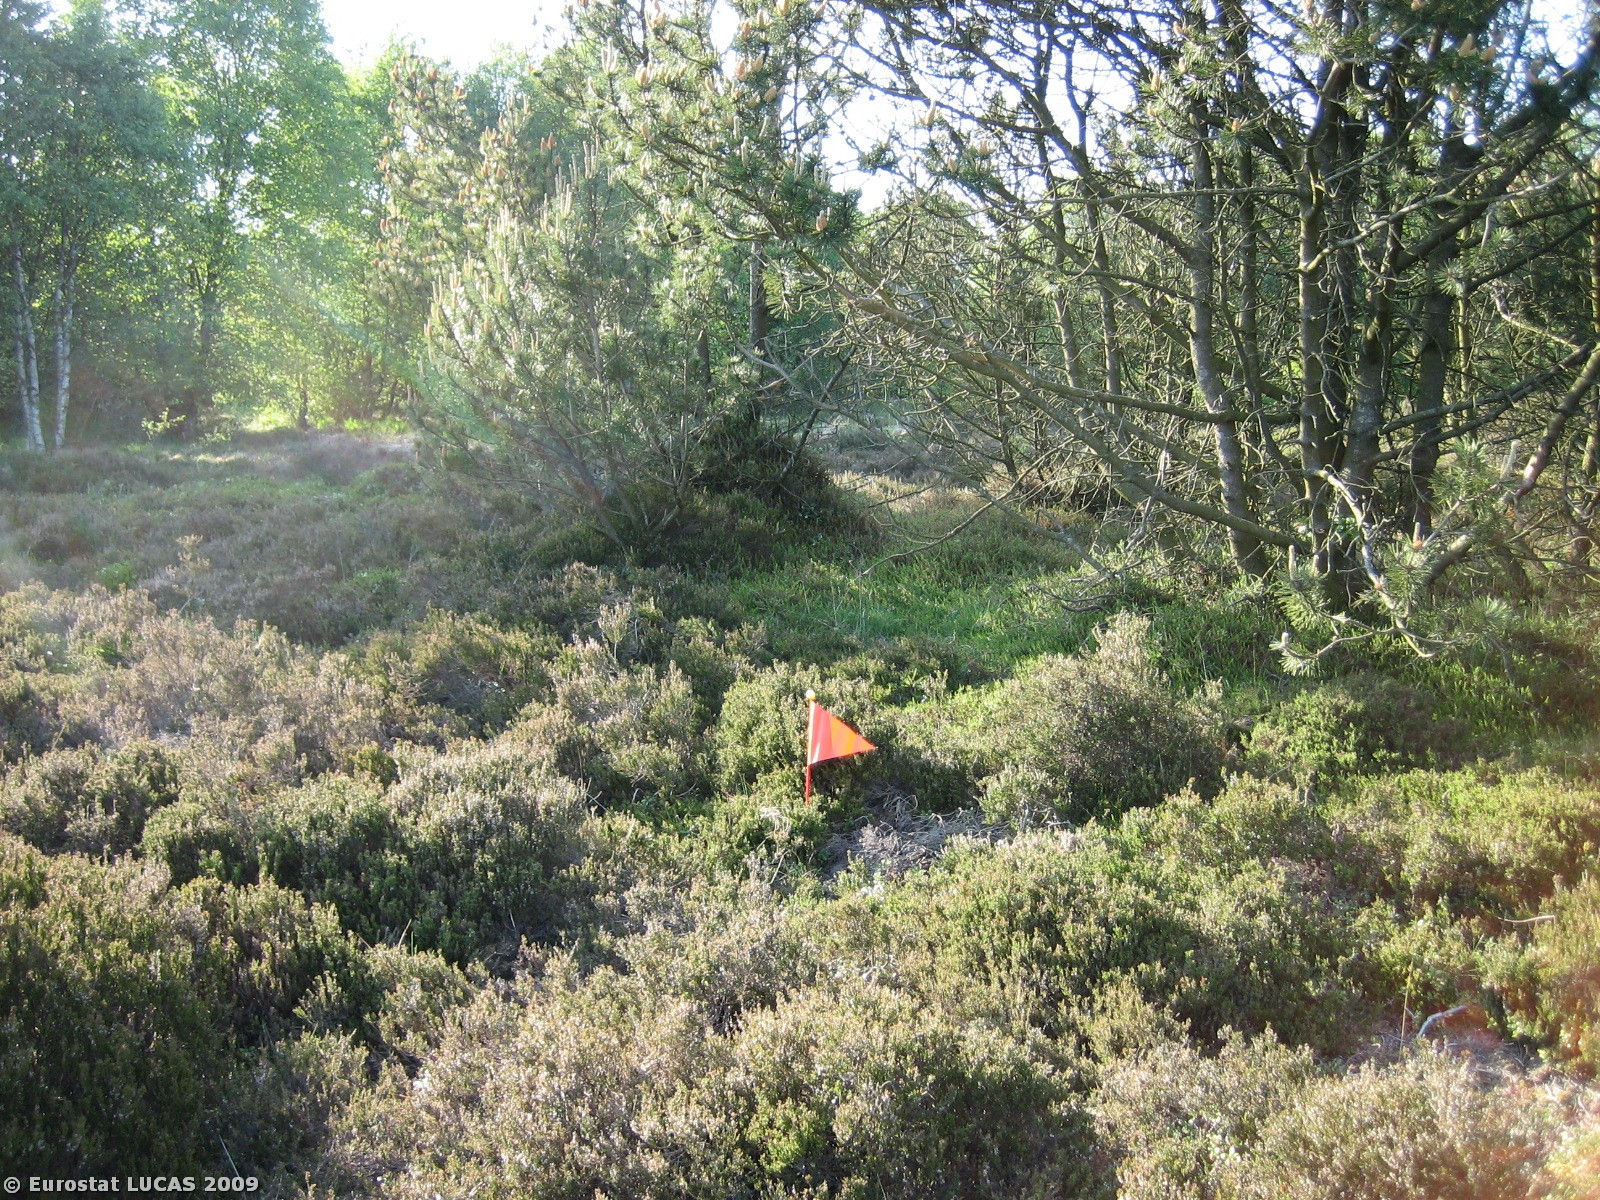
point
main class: Shrubland
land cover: Shrubland with sparse tree cover
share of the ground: > 75 %
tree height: > 5 m
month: May
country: DK
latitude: 55.9696
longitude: 9.2158
